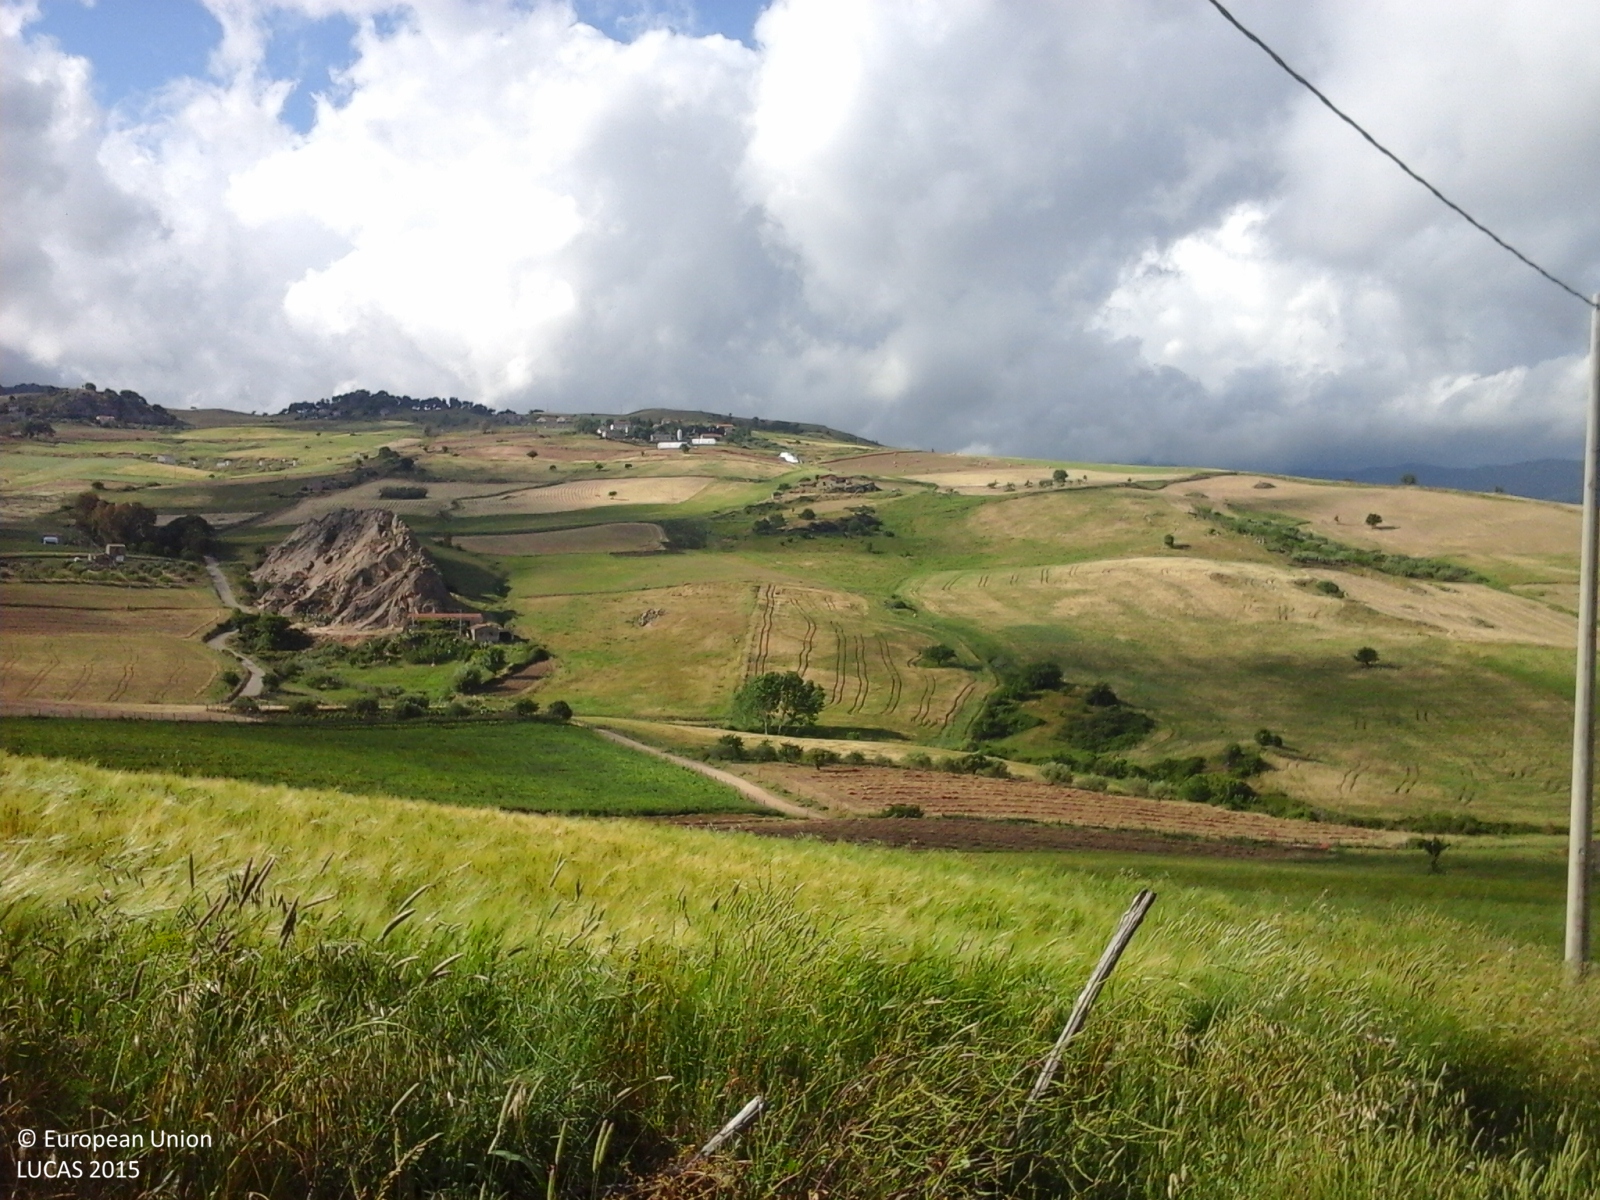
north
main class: Grassland
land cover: Grassland without tree/shrub cover
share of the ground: > 75 %
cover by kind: herbaceous plants 100 %
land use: Agriculture (excluding fallow land and kitchen gardens)
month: May
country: IT
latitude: 37.7896
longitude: 14.4314
